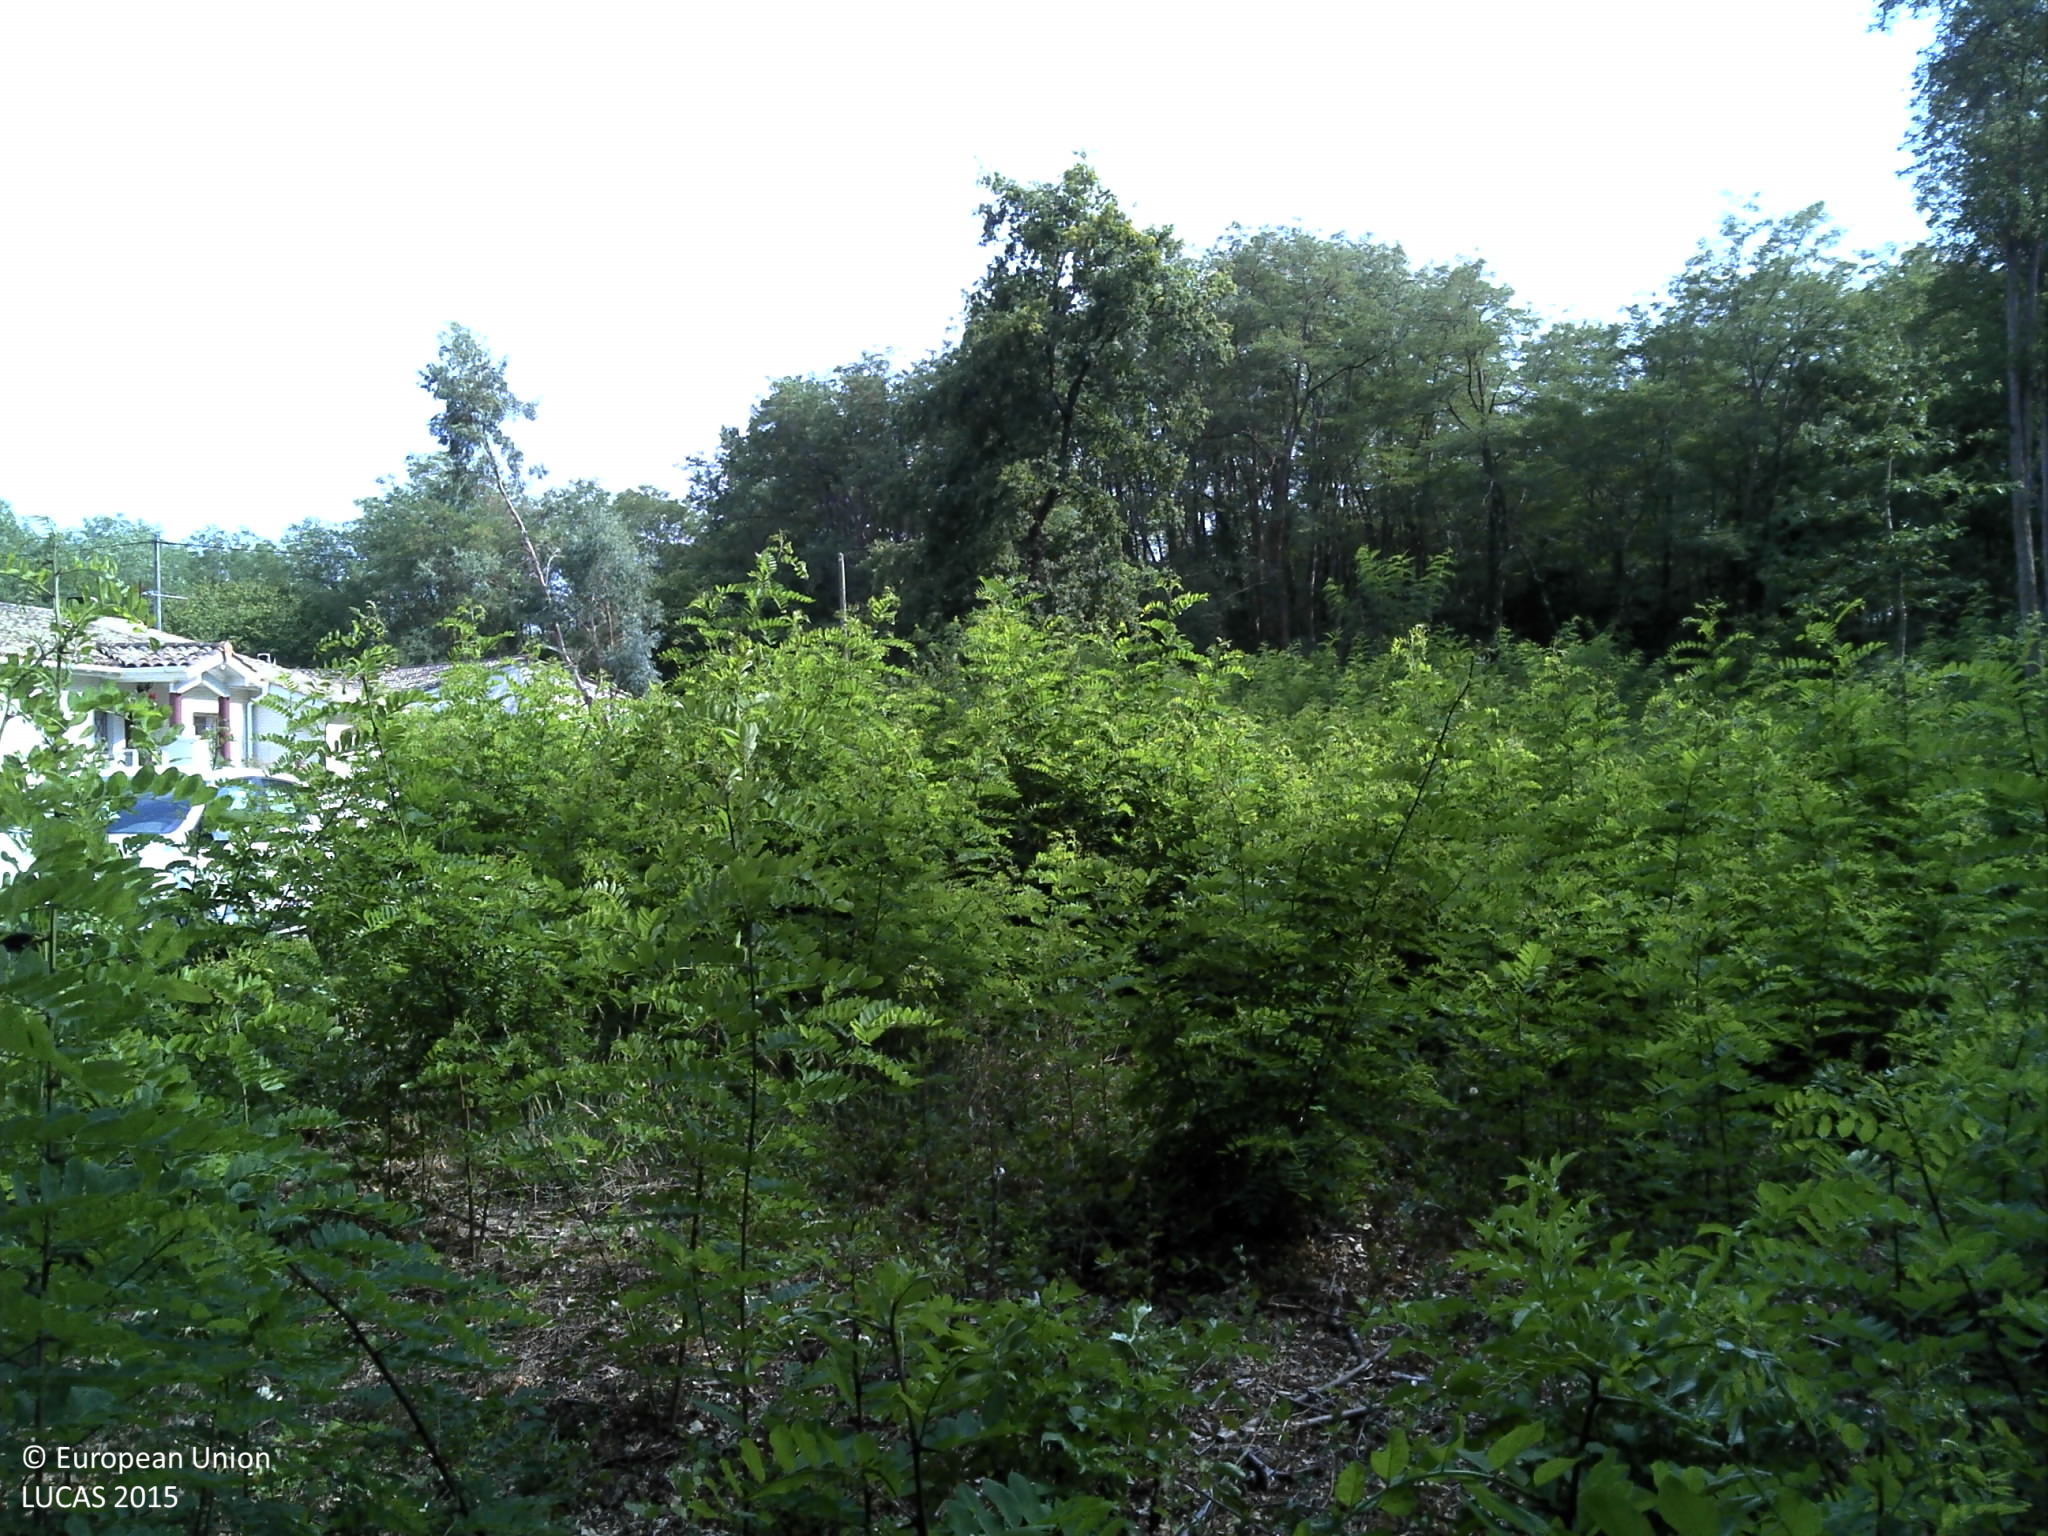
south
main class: Woodland
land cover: Broadleaved woodland
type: thermophilous deciduous forest
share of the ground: > 75 %
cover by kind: broadleaved forest trees 40 %, herbaceous plants 40 %, shrubs 20 %
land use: Semi-natural and natural areas not in use
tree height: > 5 m
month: August
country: FR
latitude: 45.0551
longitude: -0.4693
